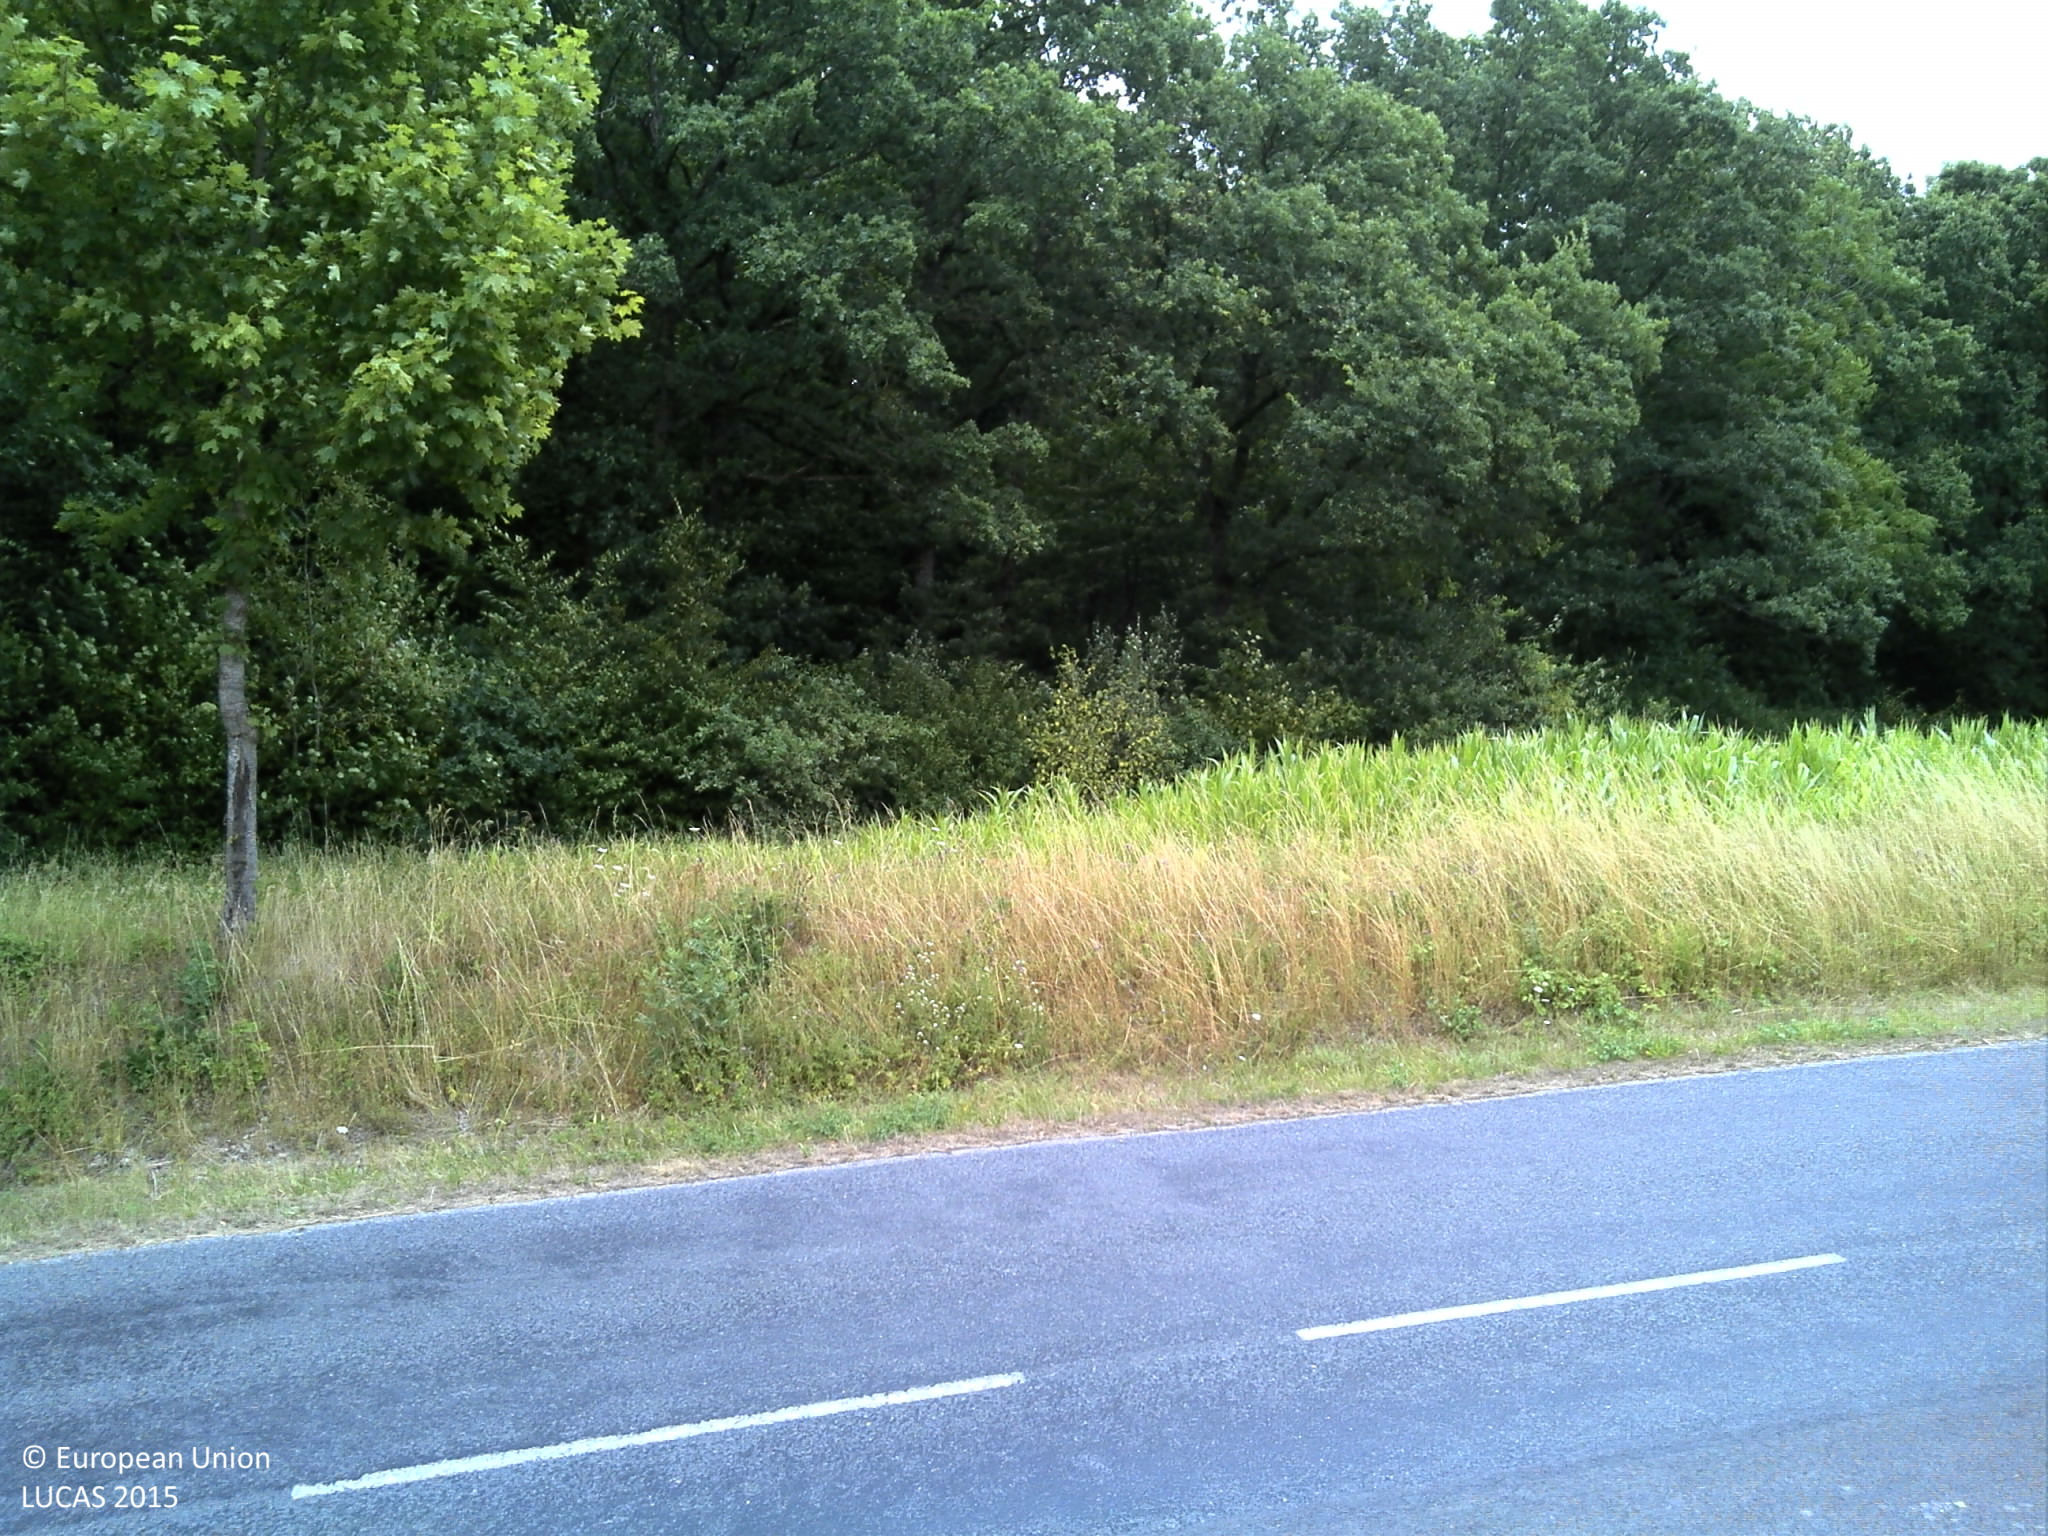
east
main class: Cropland
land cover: Barley
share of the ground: > 75 %
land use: Agriculture (excluding fallow land and kitchen gardens)
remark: Harvested field
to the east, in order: Barley; Fences; Lines of trees; Grass margins; Ditches and canals; Paved roads, cycling and walking lanes; Grass margins; Lines of trees; Broadleaved woodland
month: July
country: FR
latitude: 49.1504
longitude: 4.8836
